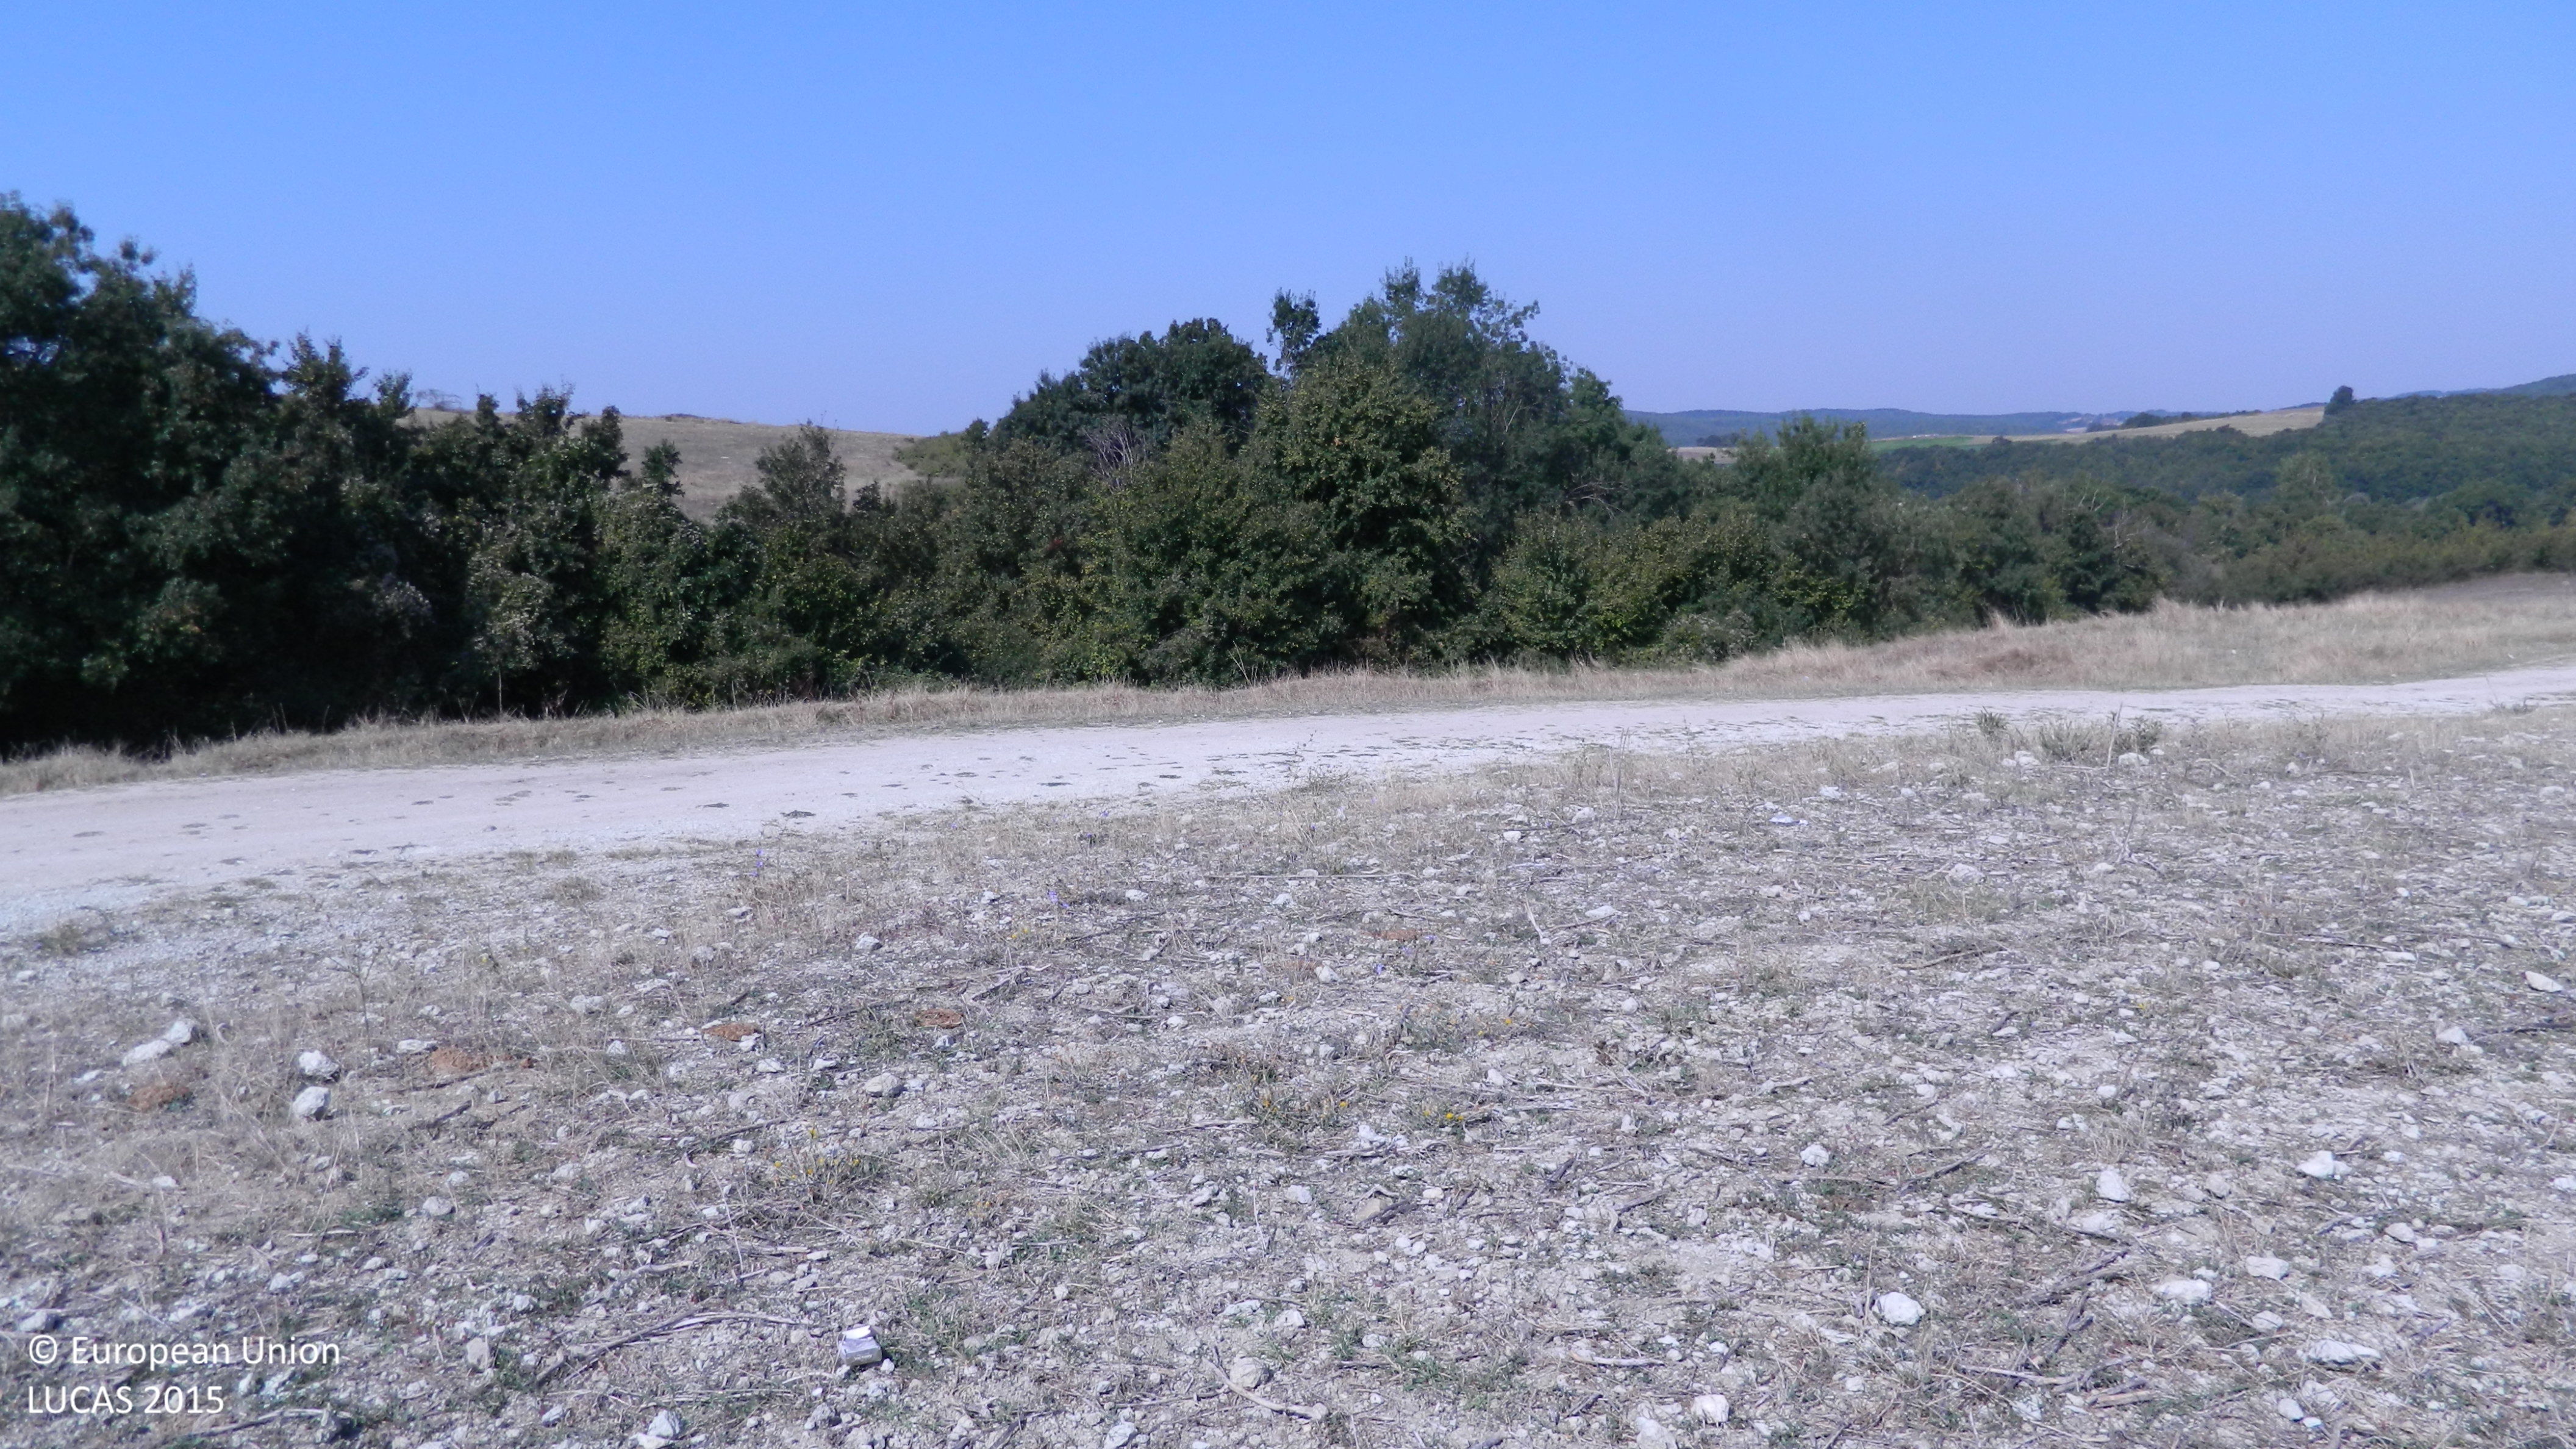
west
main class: Grassland
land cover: Spontaneously vegetated surfaces
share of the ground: 50 - 75 %
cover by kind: herbaceous plants 70 %, unconsolidated bare surface 30 %
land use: Agriculture (excluding fallow land and kitchen gardens)
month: September
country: BG
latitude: 41.7144
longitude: 25.7014
